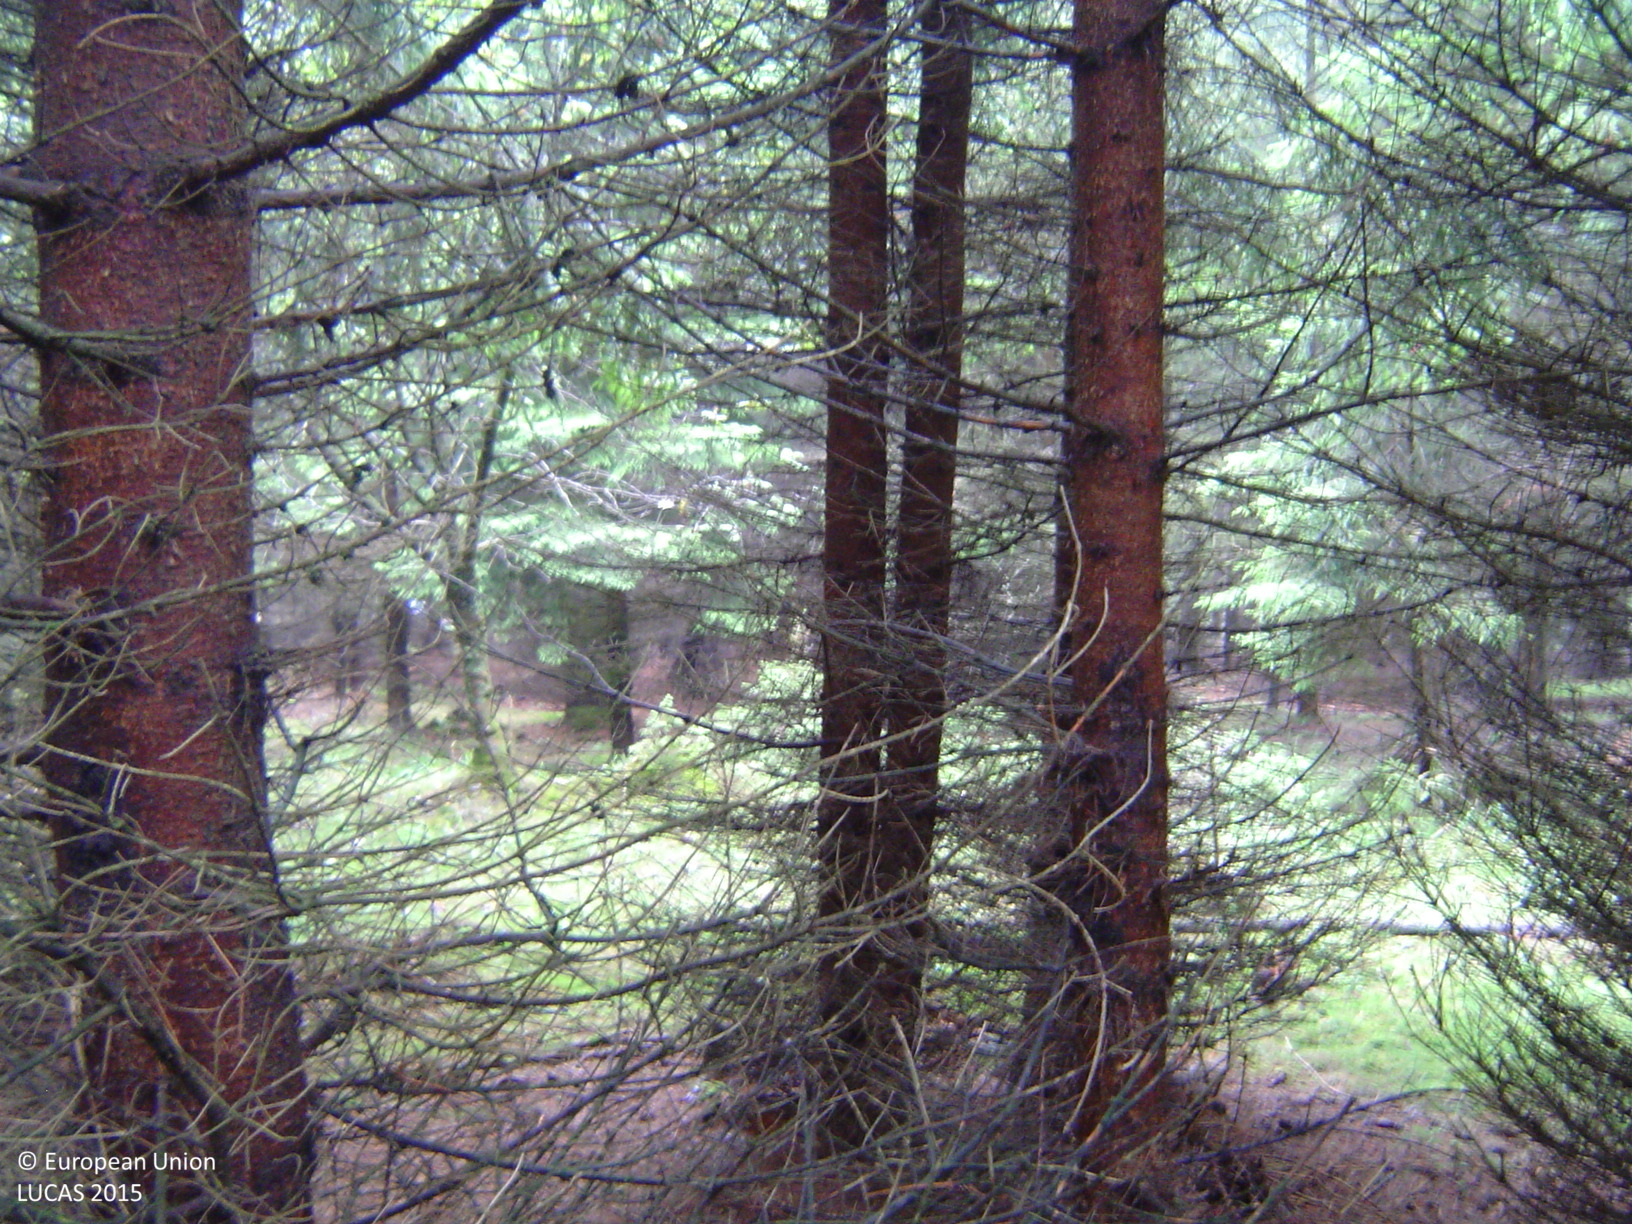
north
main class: Woodland
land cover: Spruce dominated coniferous woodland
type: hemiboreal forest and nemoral coniferous forest and mixed broadleaved-coniferous forest
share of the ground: > 75 %
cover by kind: coniferous forest trees 100 %
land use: Forestry
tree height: > 5 m
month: August
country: CZ
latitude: 49.6885
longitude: 13.8124
